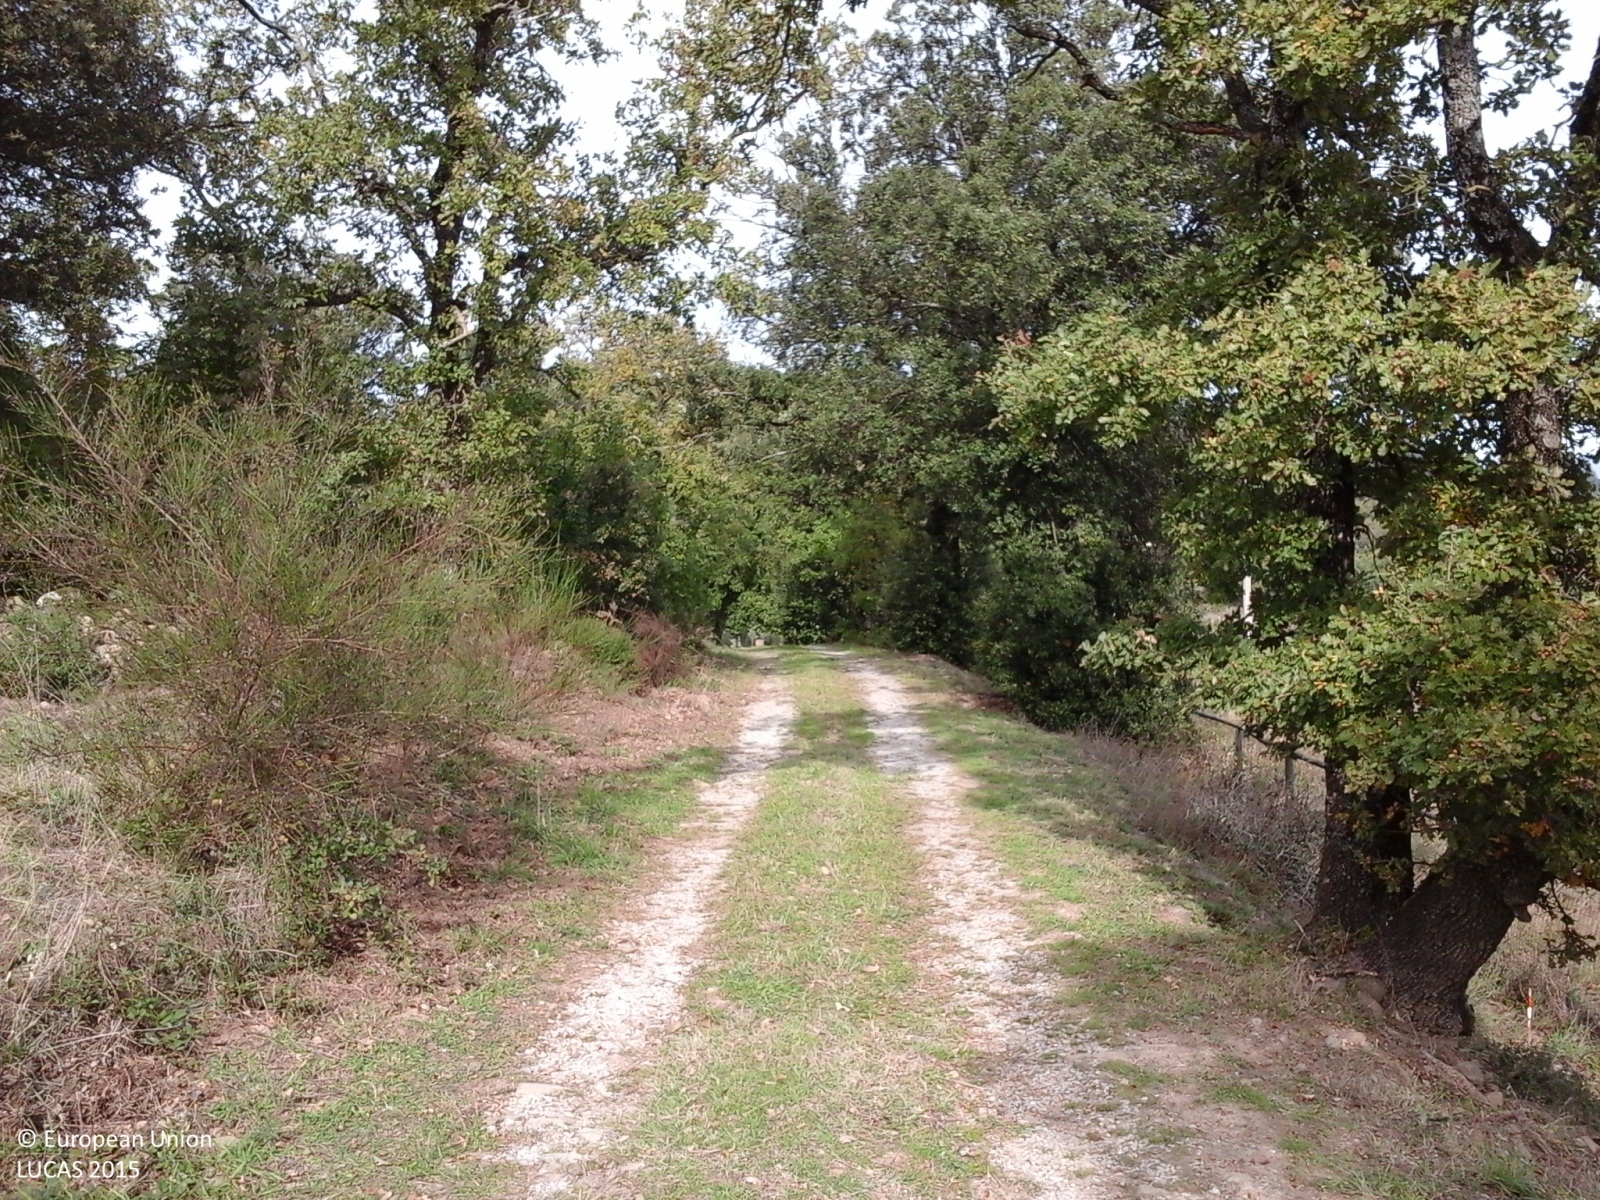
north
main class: Grassland
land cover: Grassland without tree/shrub cover
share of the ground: > 75 %
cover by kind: herbaceous plants 100 %
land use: Agriculture (excluding fallow land and kitchen gardens)
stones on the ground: < 10 %
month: October
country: IT
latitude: 43.4184
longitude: 11.5642
